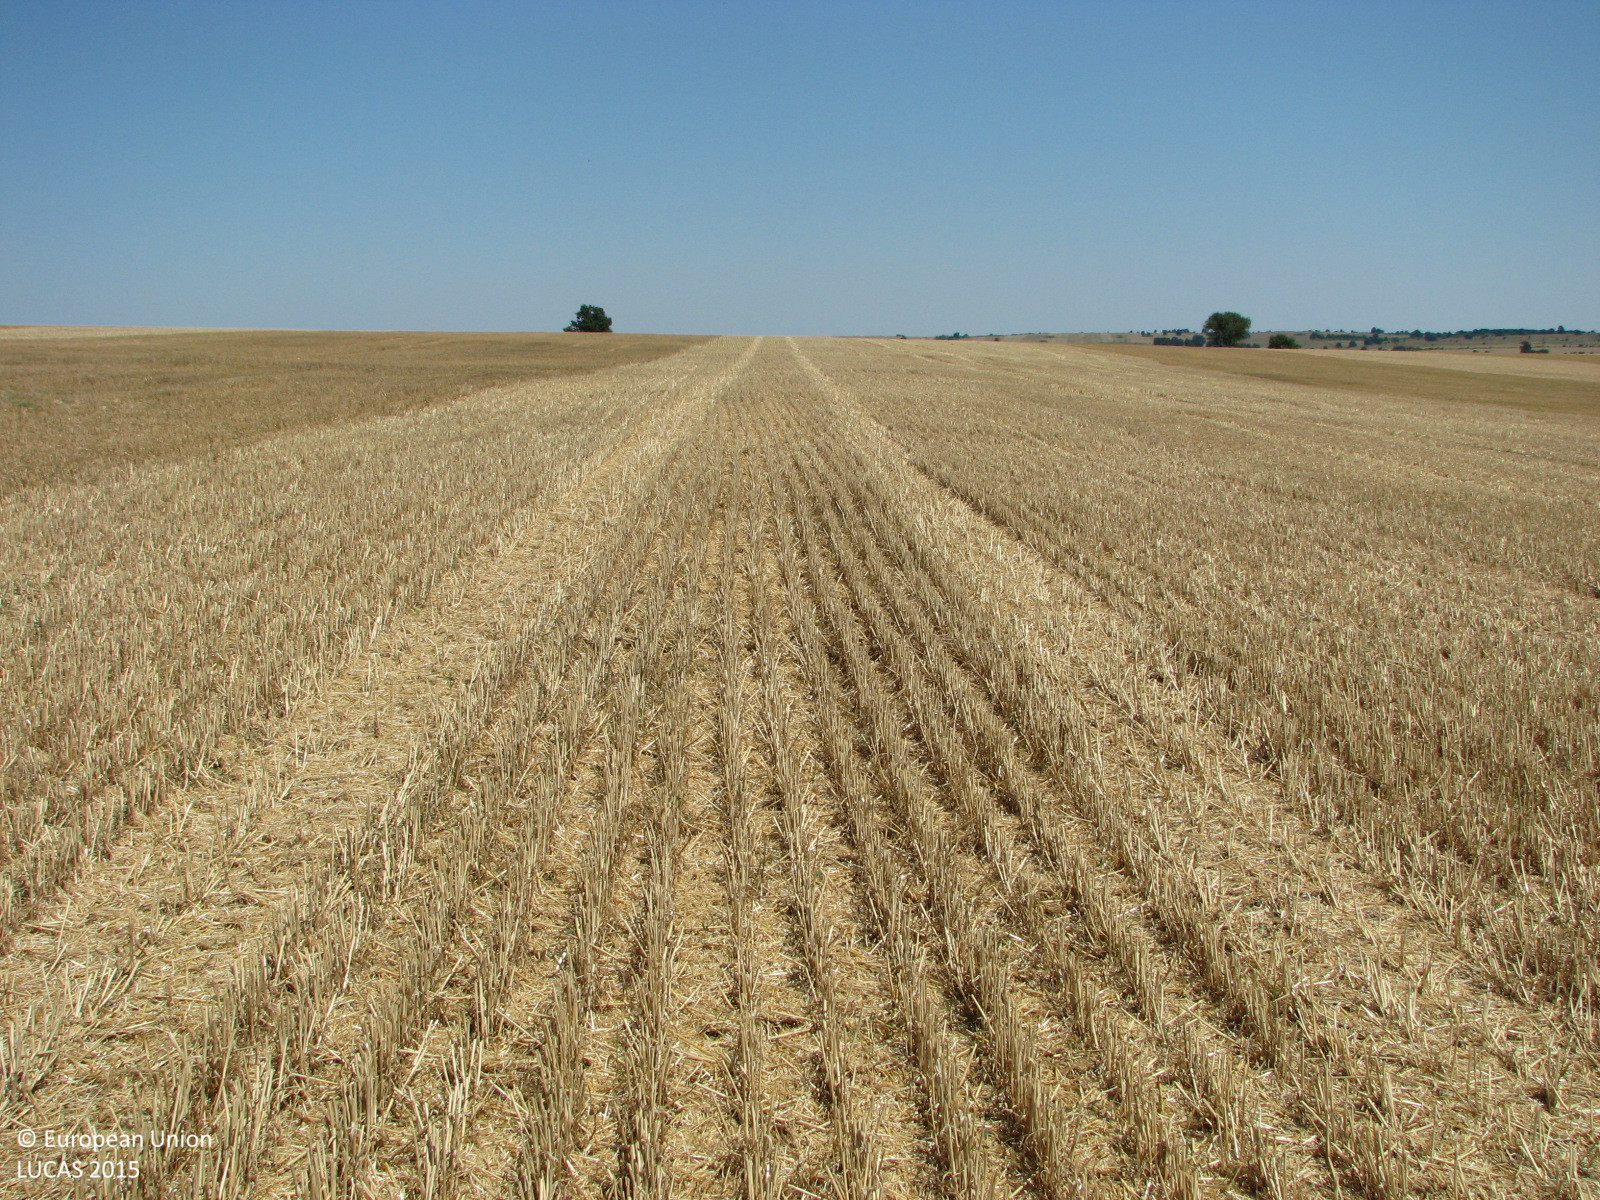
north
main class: Cropland
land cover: Common wheat
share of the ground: 25 - 50 %
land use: Agriculture (excluding fallow land and kitchen gardens)
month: July
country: BG
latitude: 42.1889
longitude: 26.8428
